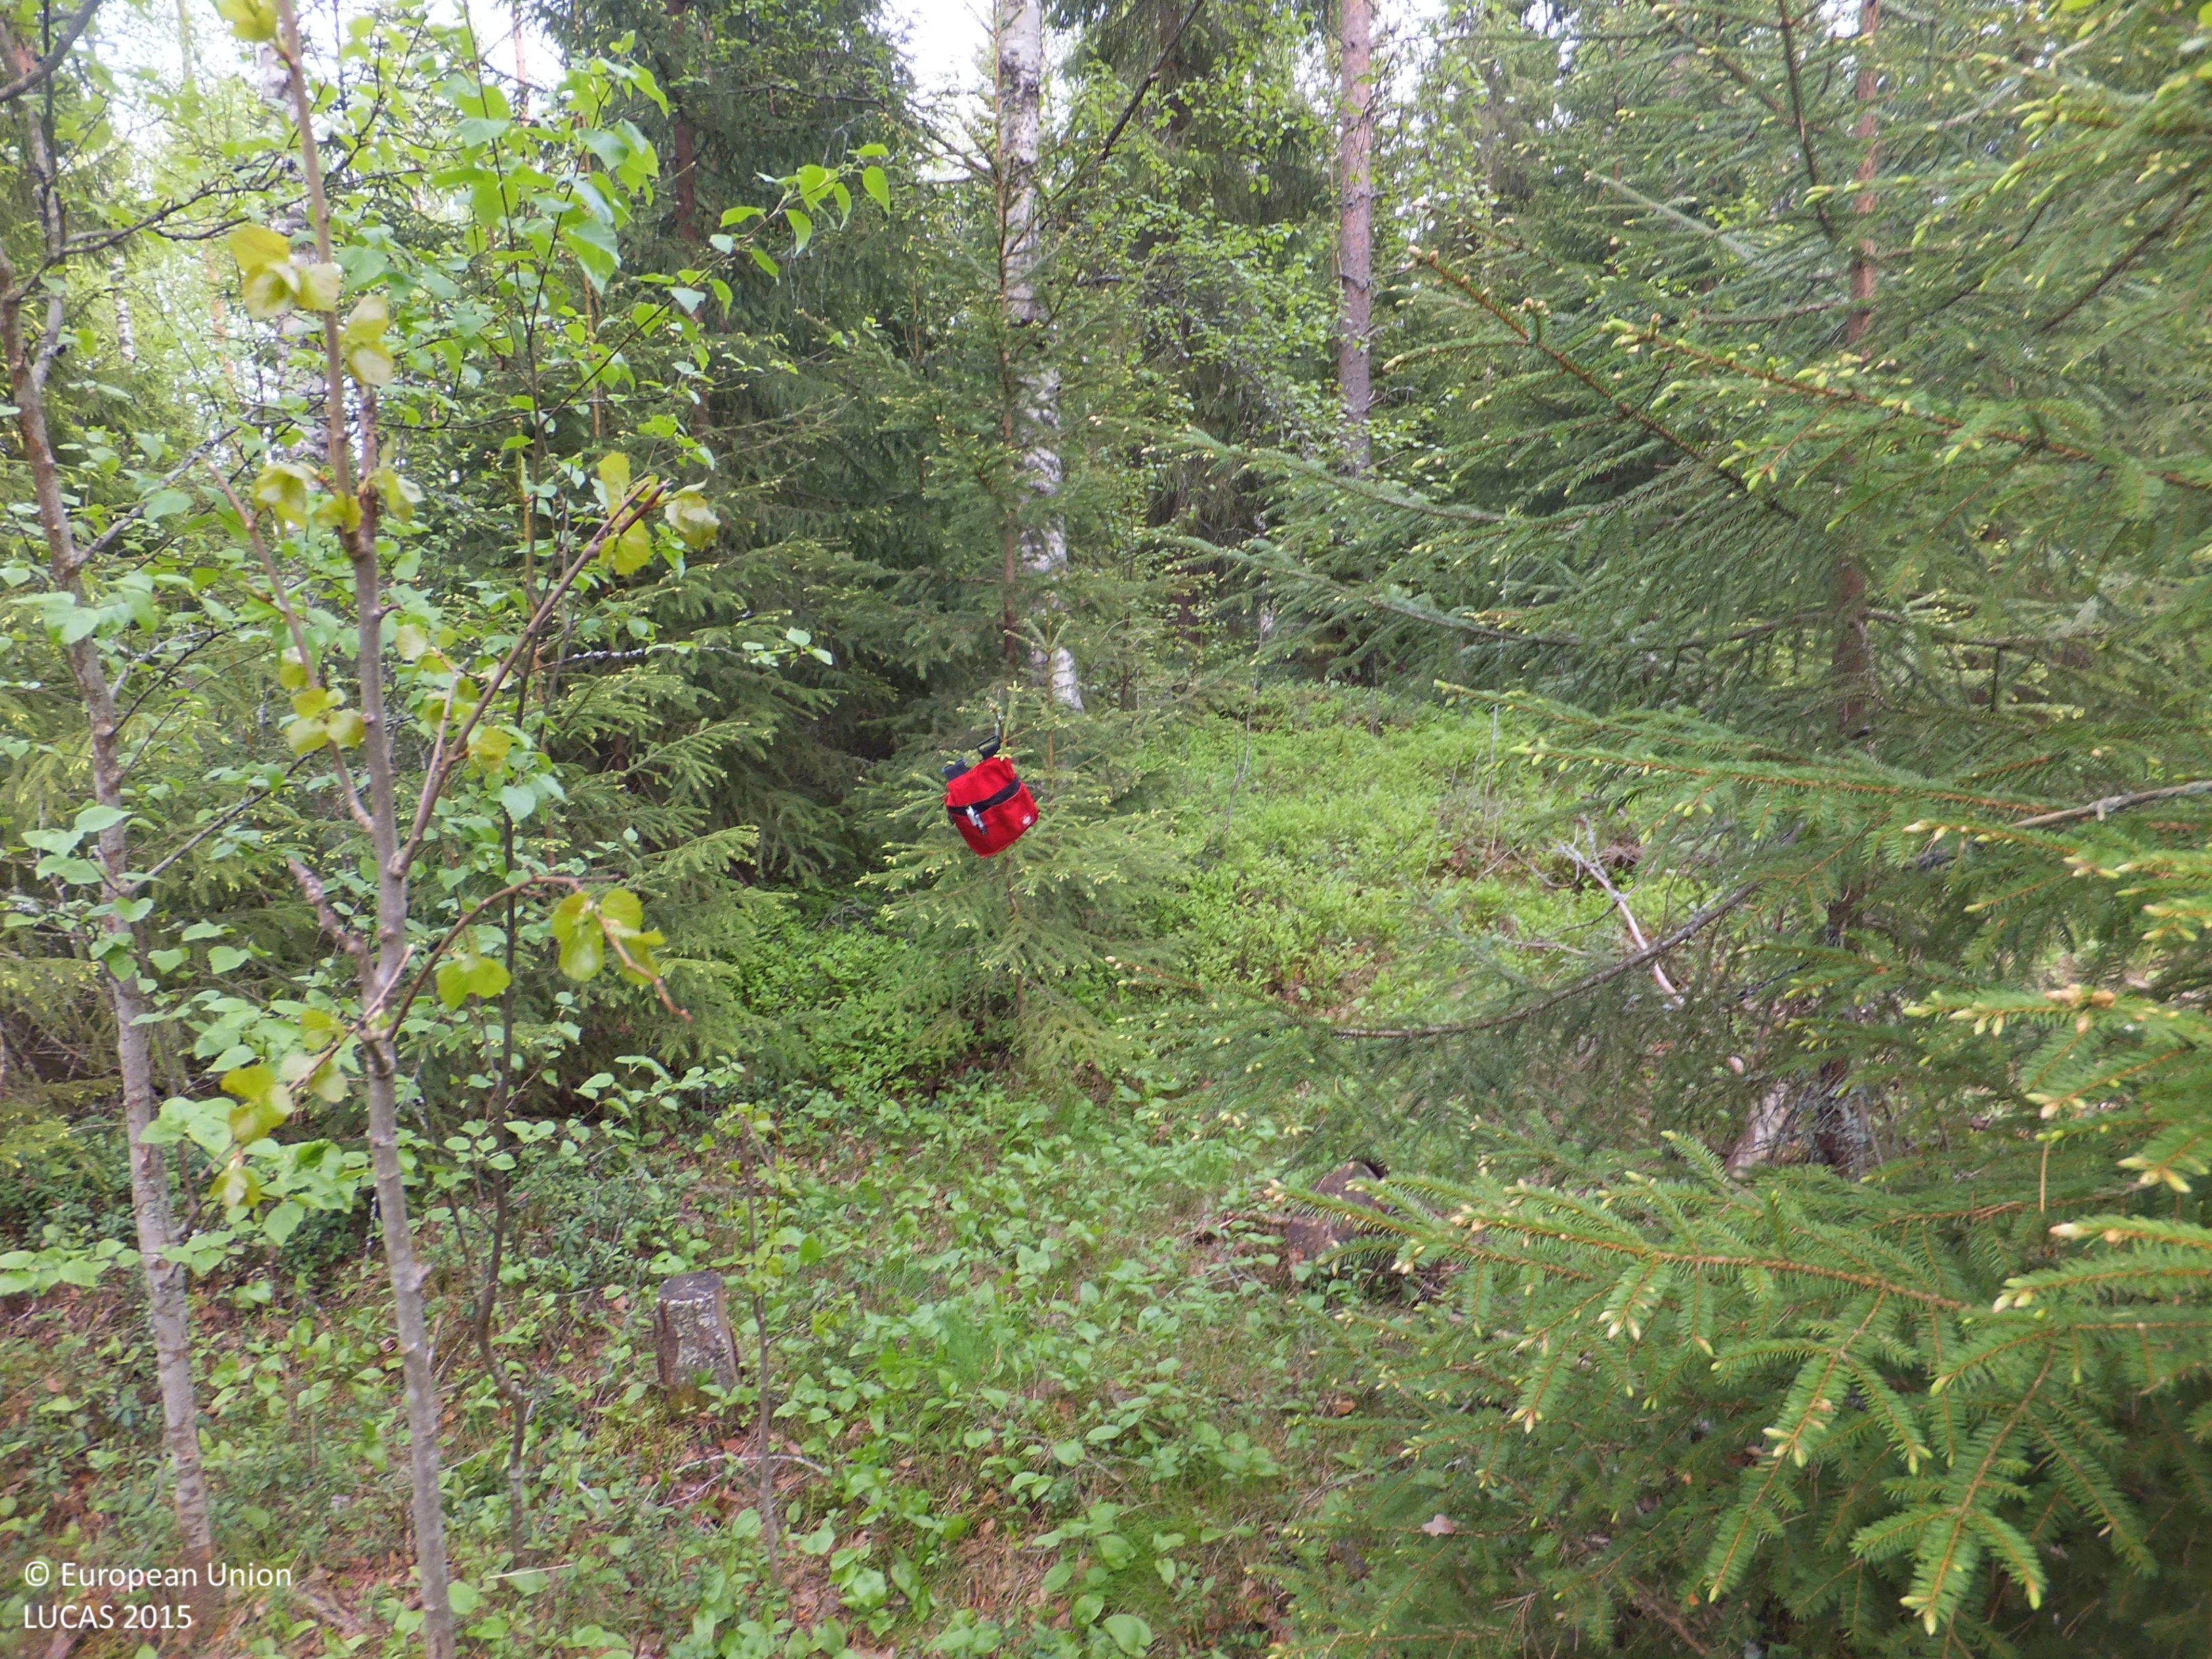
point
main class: Woodland
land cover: Pine dominated mixed woodland
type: boreal forest
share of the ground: 50 - 75 %
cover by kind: herbaceous plants 45 %, coniferous forest trees 30 %, broadleaved forest trees 20 %, shrubs 5 %
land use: Forestry
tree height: > 5 m
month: June
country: FI
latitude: 63.4324
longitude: 22.8587
